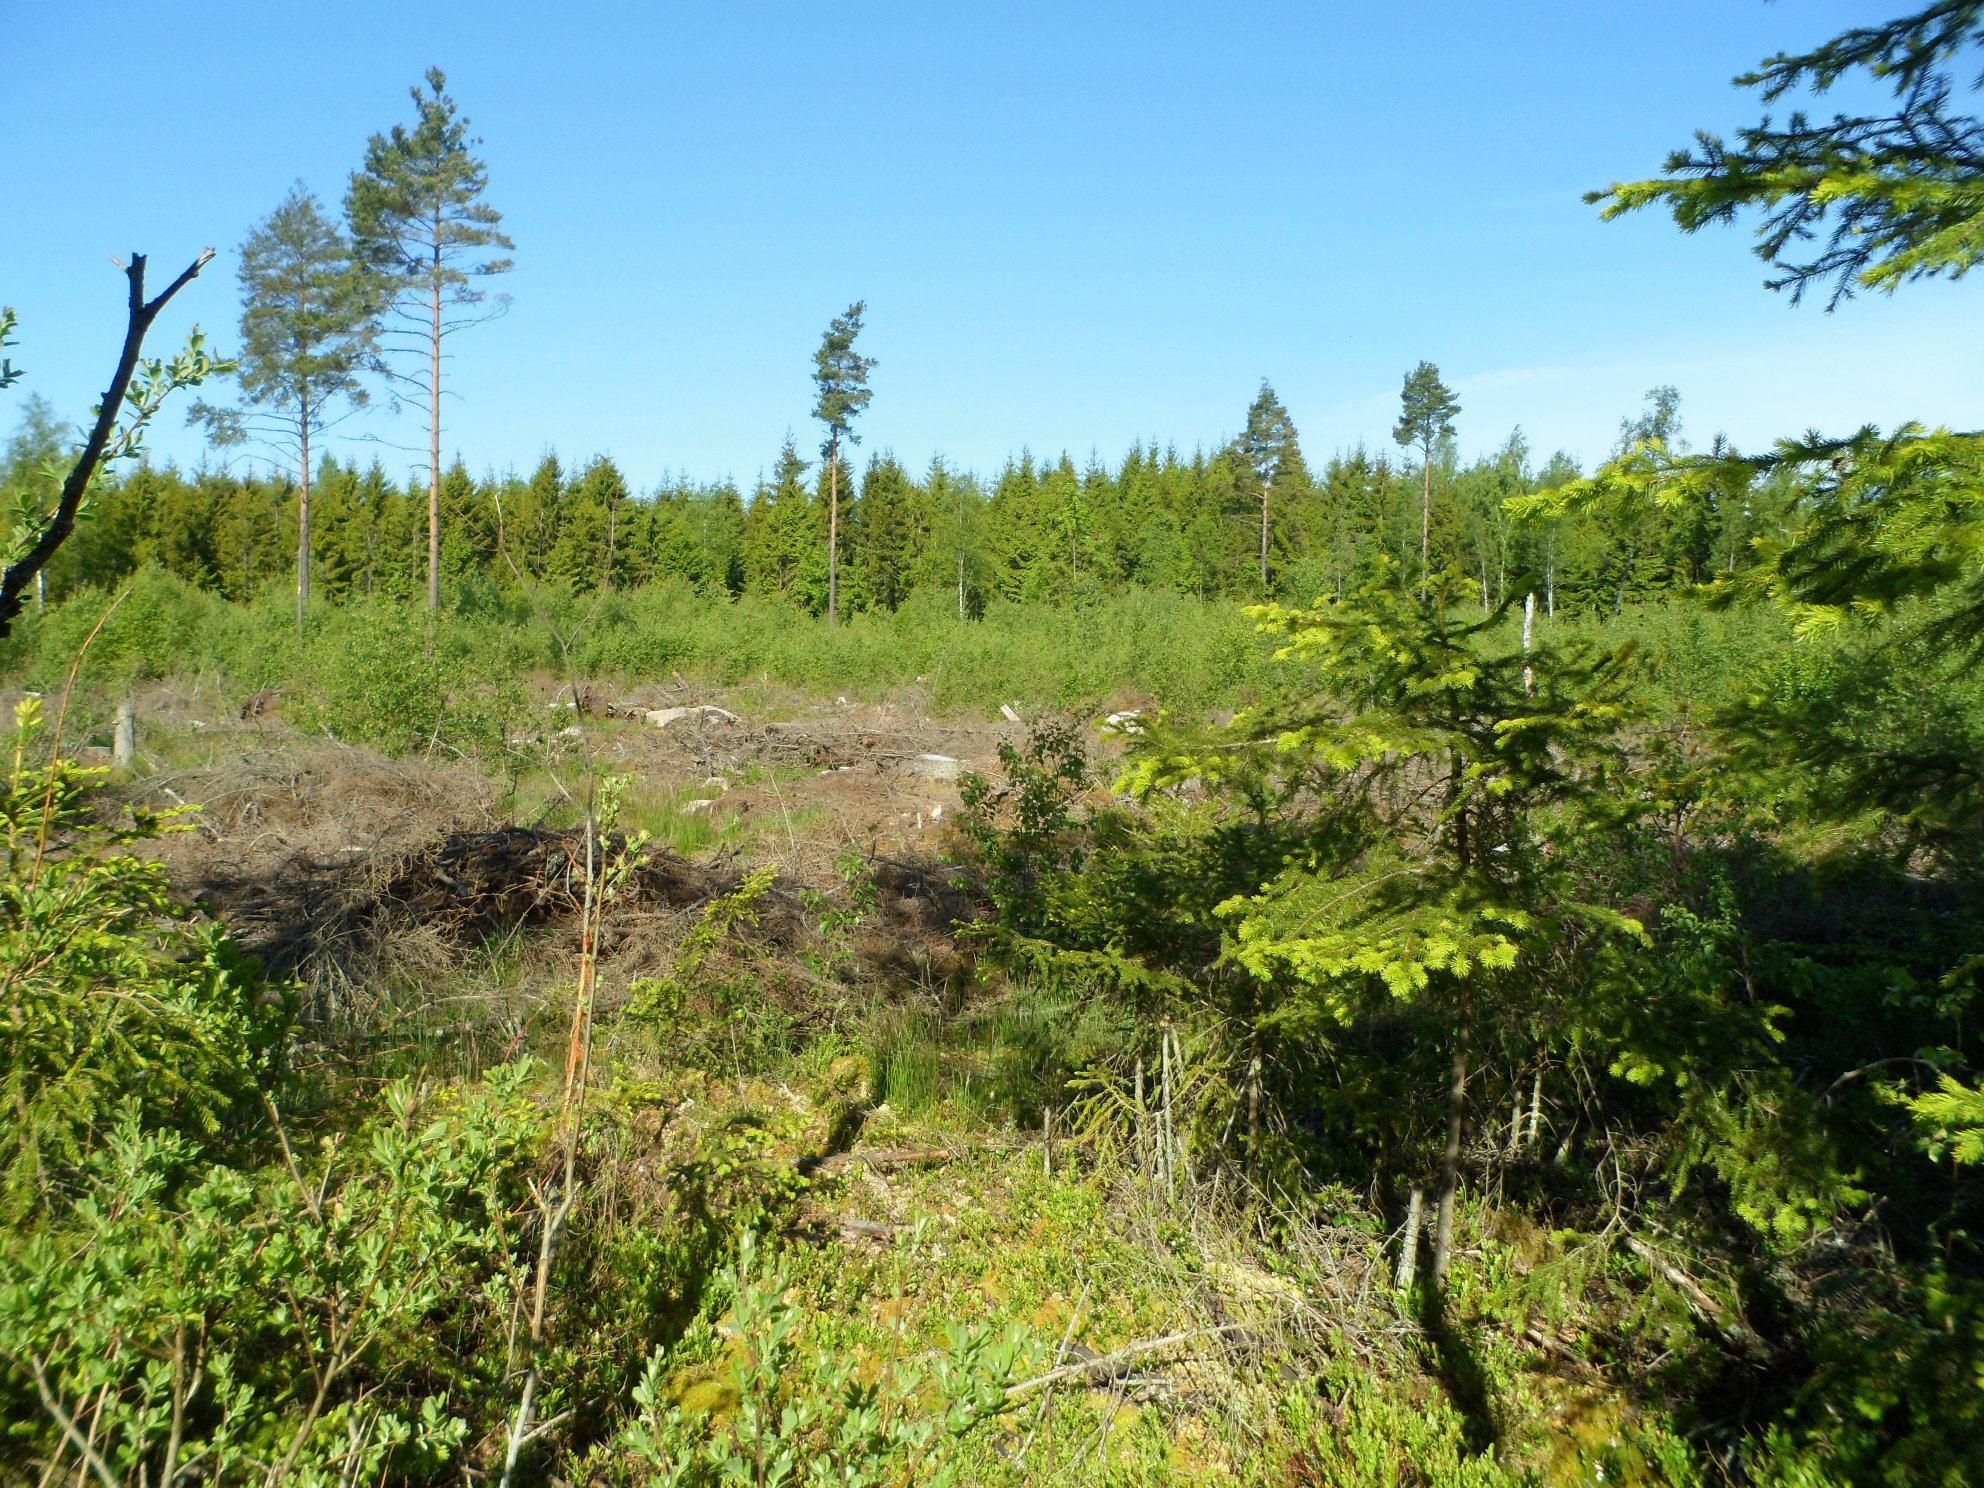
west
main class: Woodland
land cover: Spruce dominated mixed woodland
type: boreal forest
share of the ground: 50 - 75 %
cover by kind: coniferous forest trees 30 %, broadleaved forest trees 30 %, shrubs 25 %, lichens and mosses 10 %, herbaceous plants 5 %
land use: Forestry
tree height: > 5 m
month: June
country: SE
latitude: 56.8879
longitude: 14.8720
